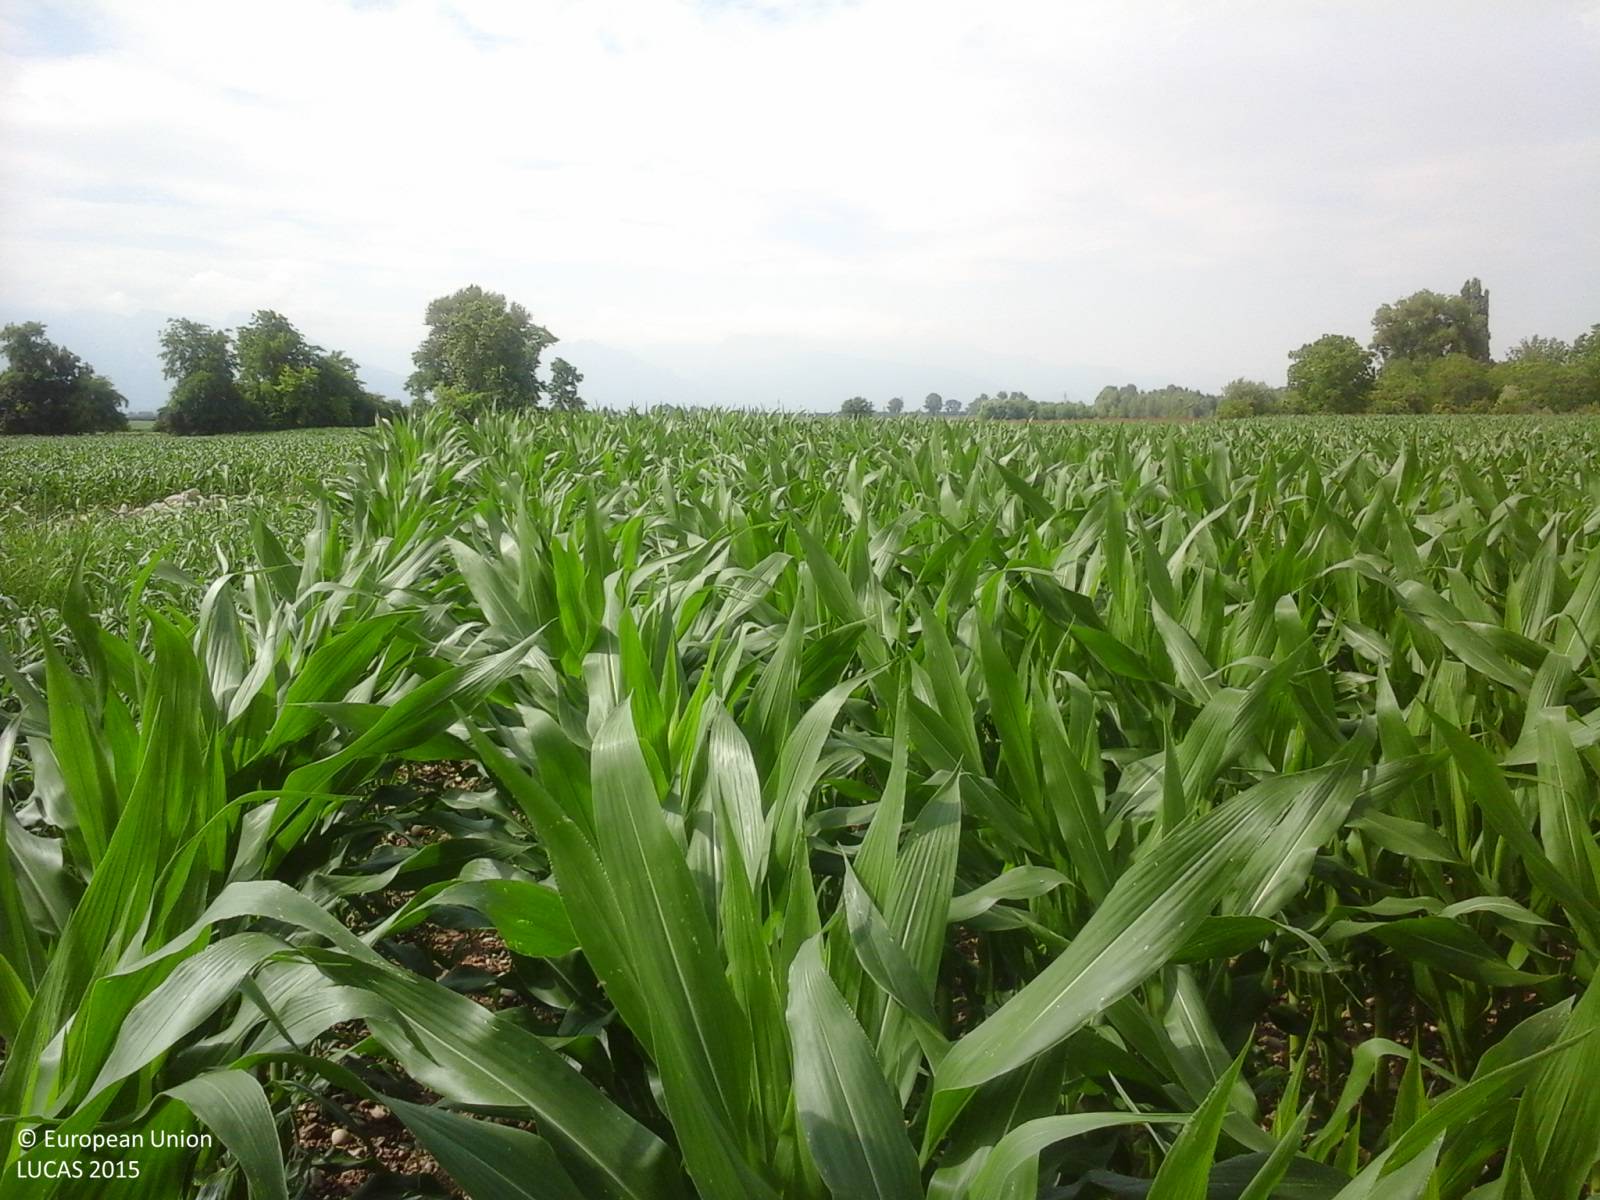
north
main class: Cropland
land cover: Maize
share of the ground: > 75 %
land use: Agriculture (excluding fallow land and kitchen gardens)
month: June
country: IT
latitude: 46.0102
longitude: 12.7217
